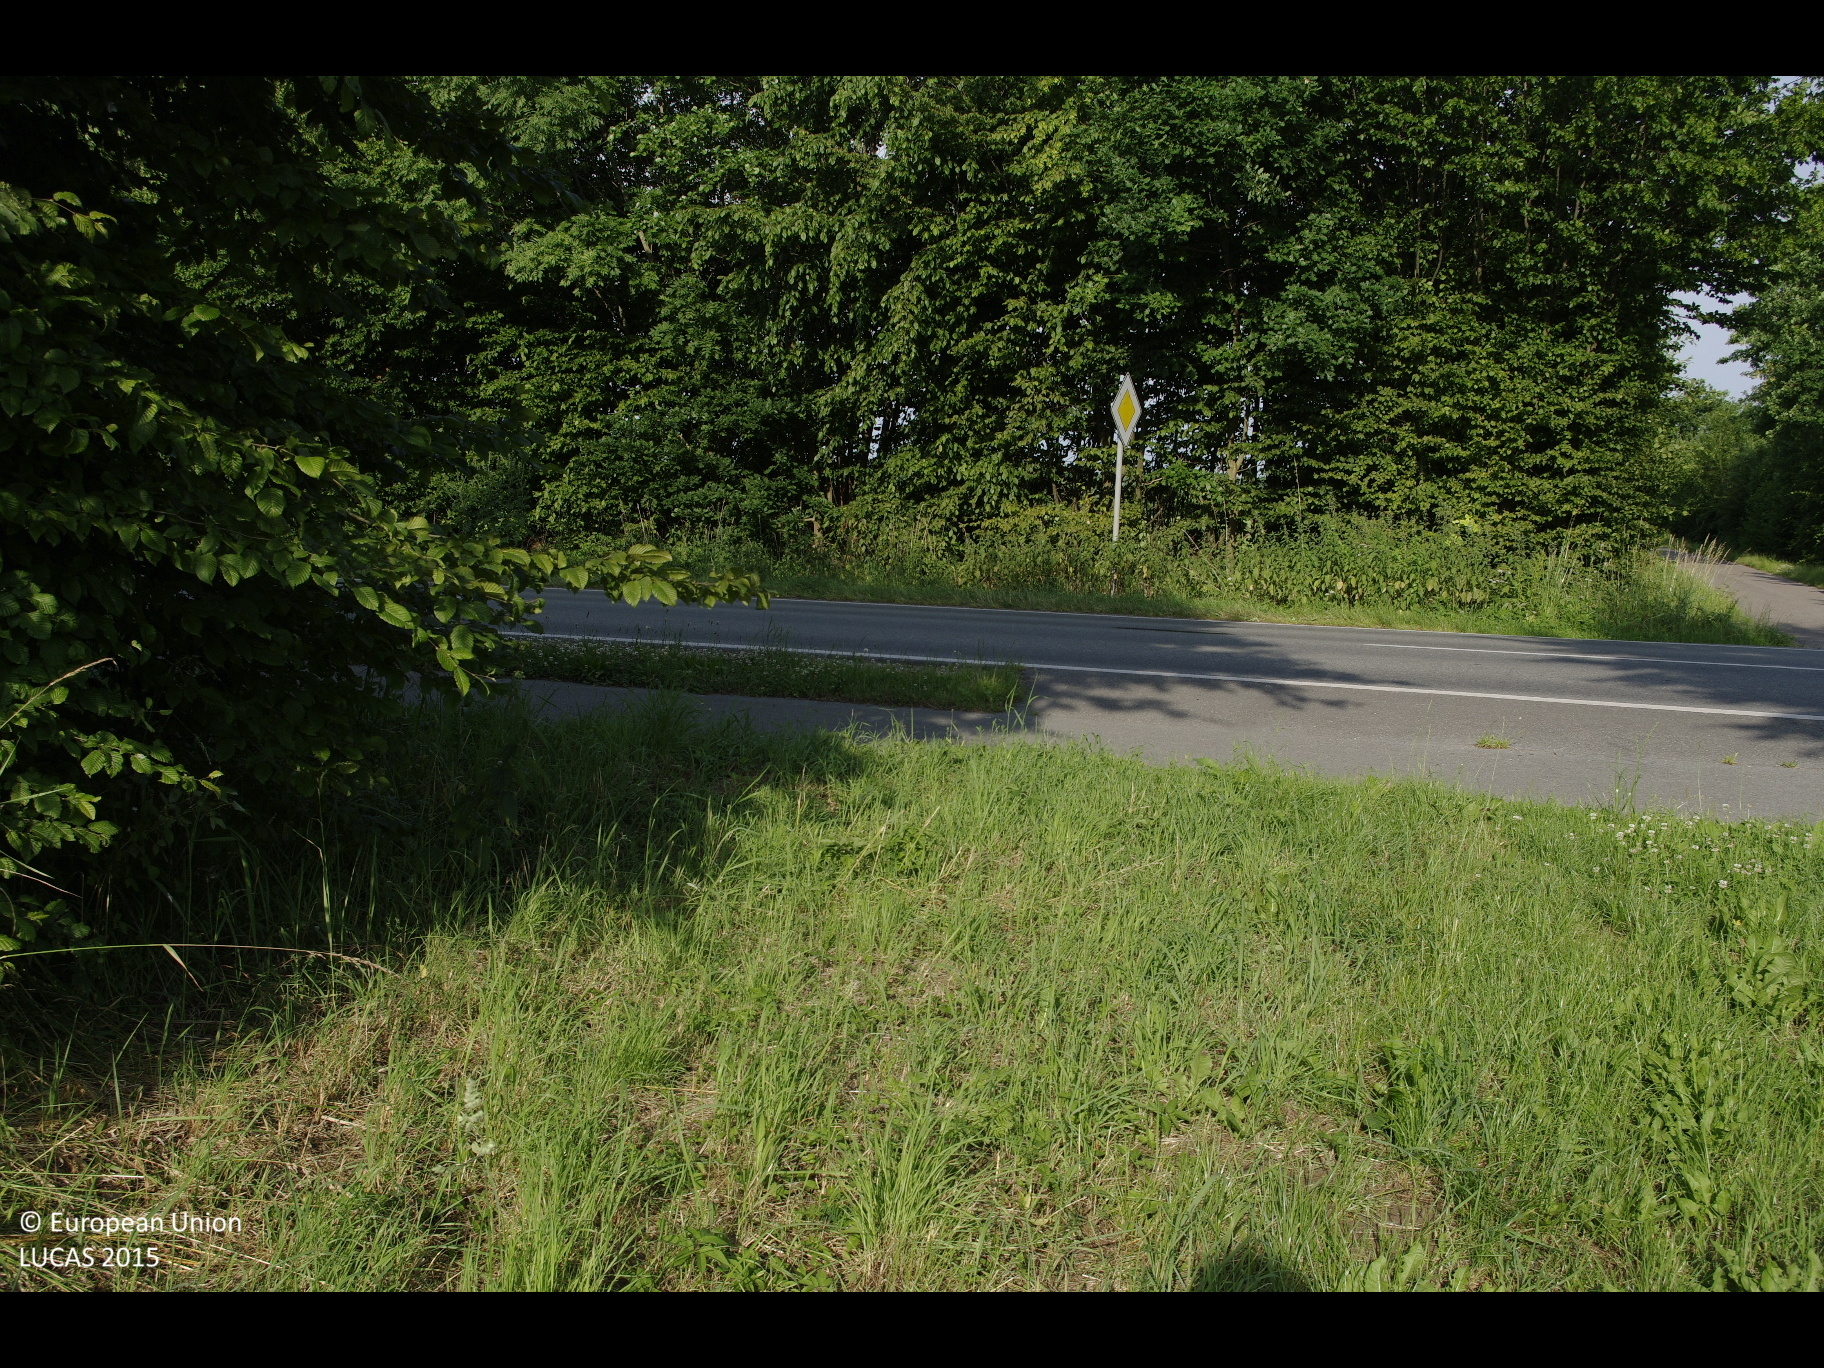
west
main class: Cropland
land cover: Rye
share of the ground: > 75 %
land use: Agriculture (excluding fallow land and kitchen gardens)
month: July
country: DE
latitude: 53.7957
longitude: 10.6221
